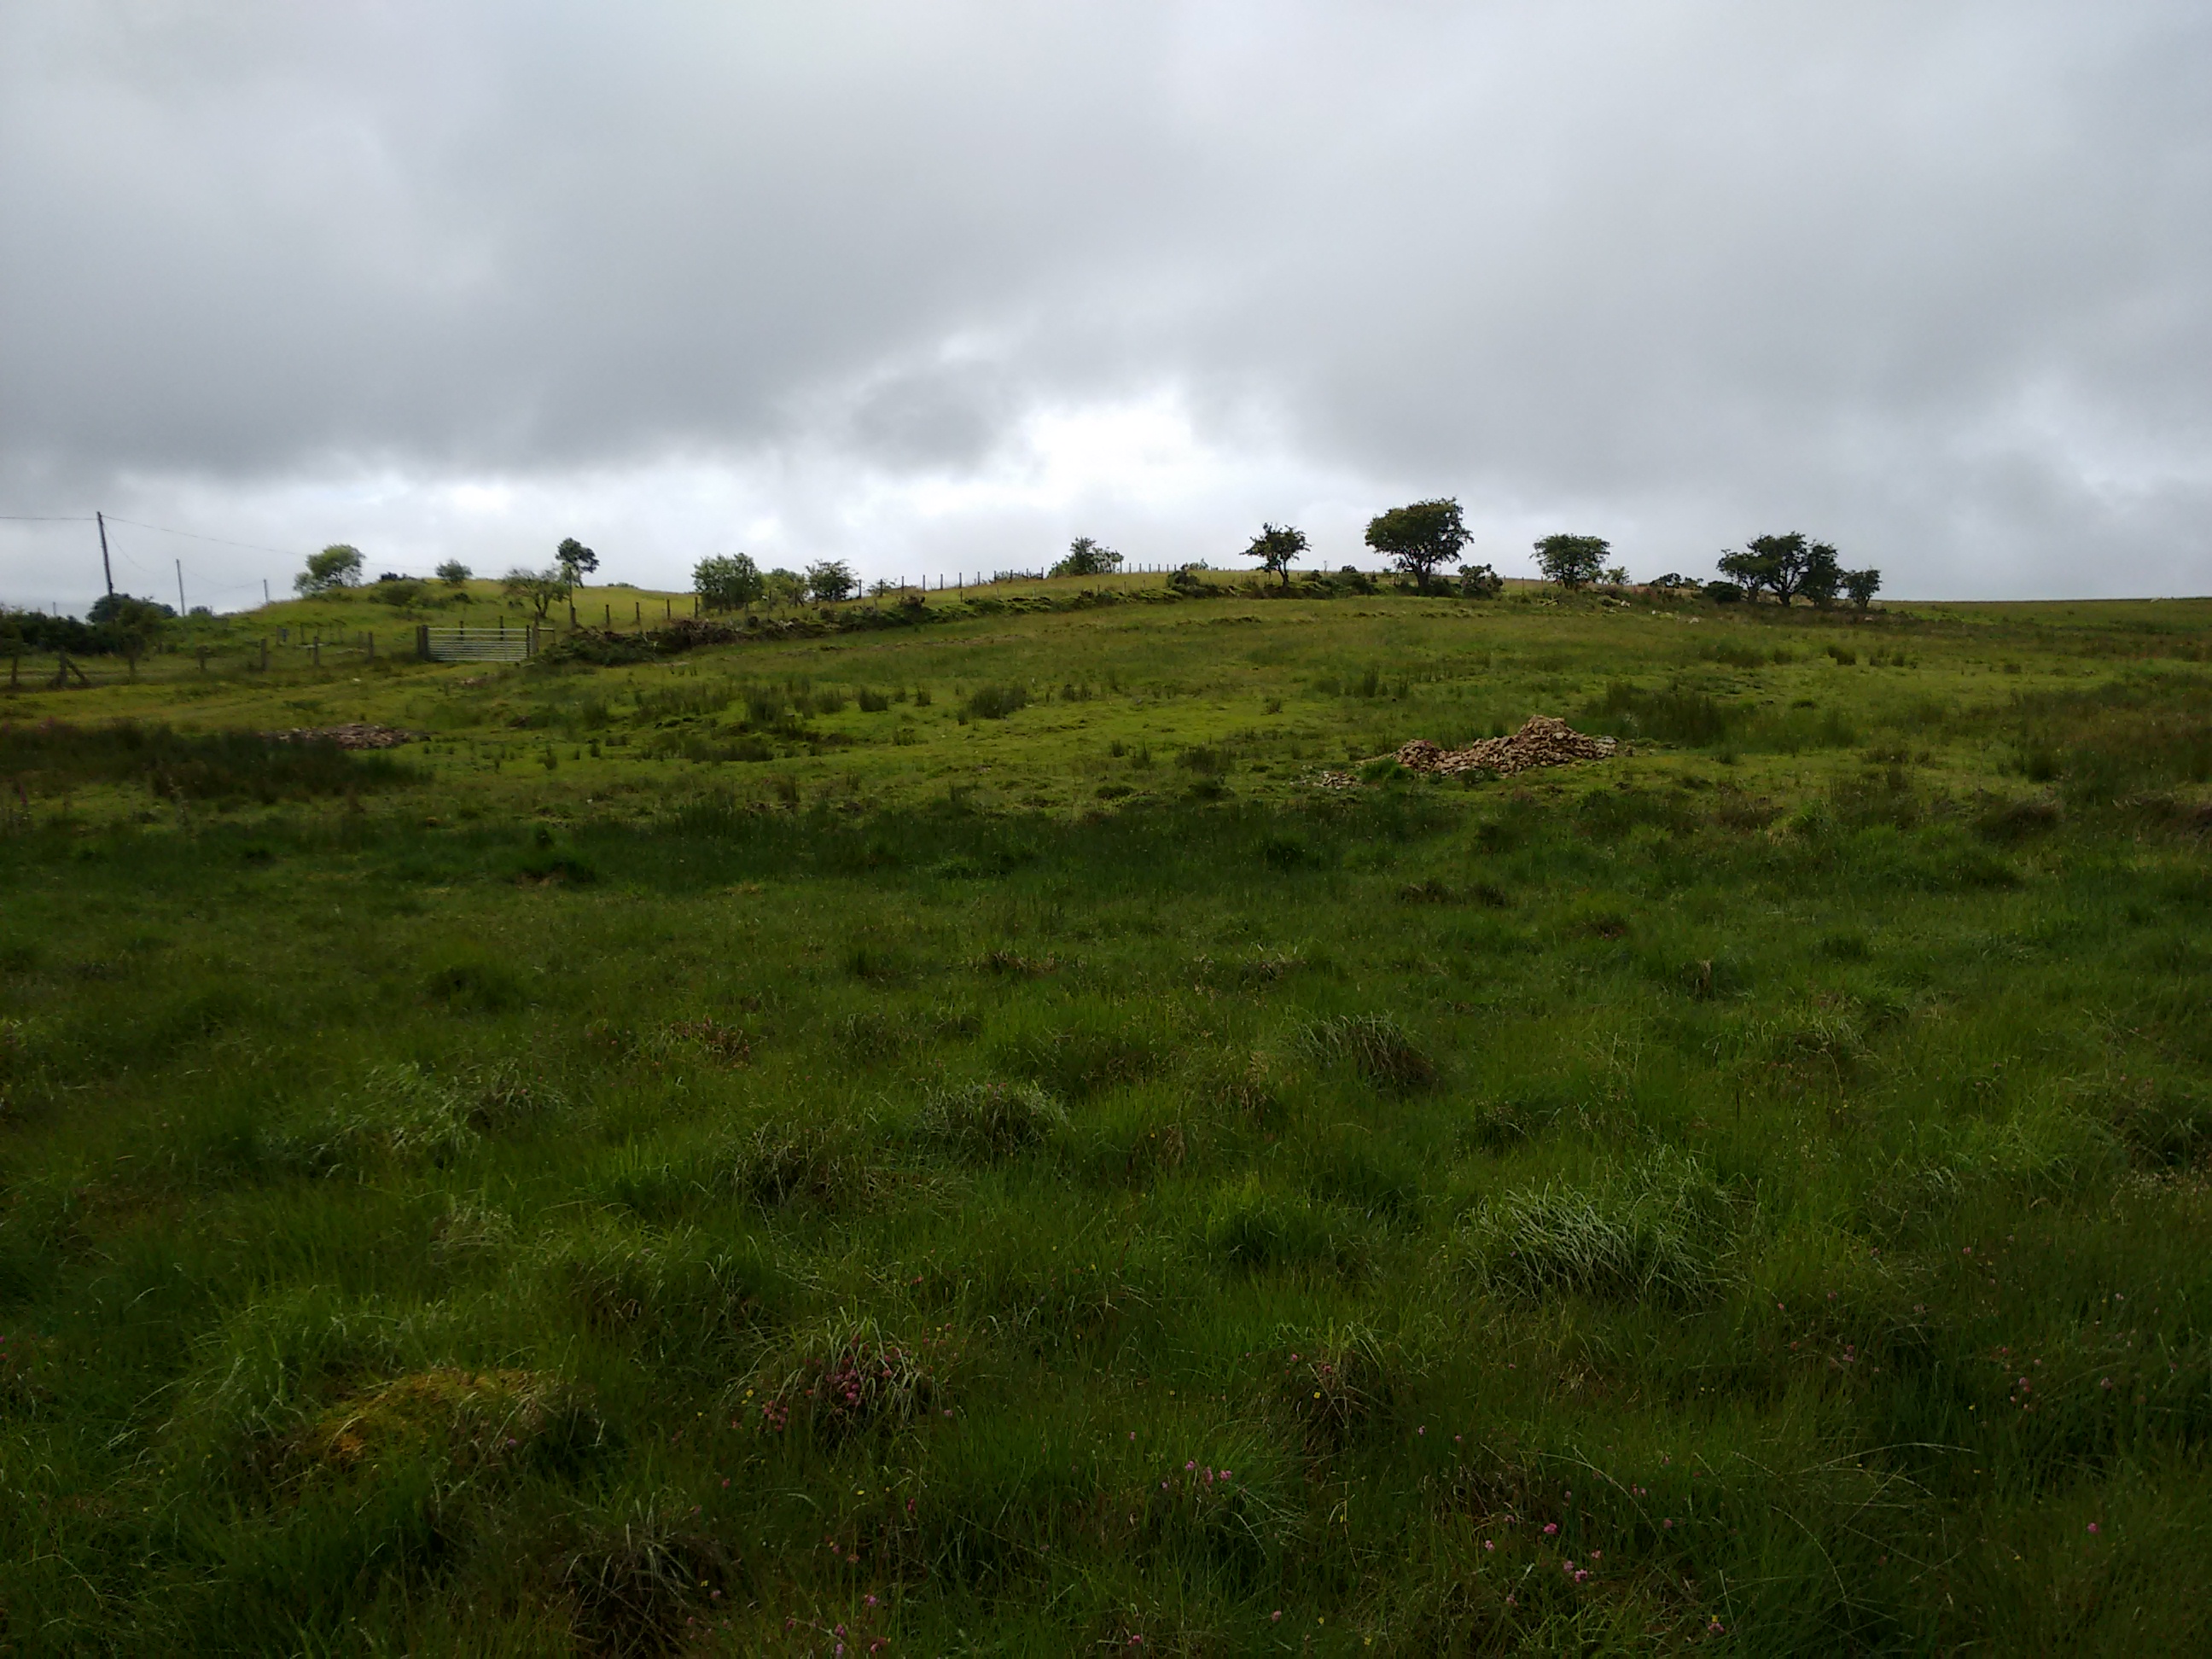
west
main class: Grassland
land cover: Grassland without tree/shrub cover
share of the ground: > 75 %
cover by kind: herbaceous plants 100 %
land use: Agriculture (excluding fallow land and kitchen gardens)
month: July
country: GB
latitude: 54.6553
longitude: -6.9875
